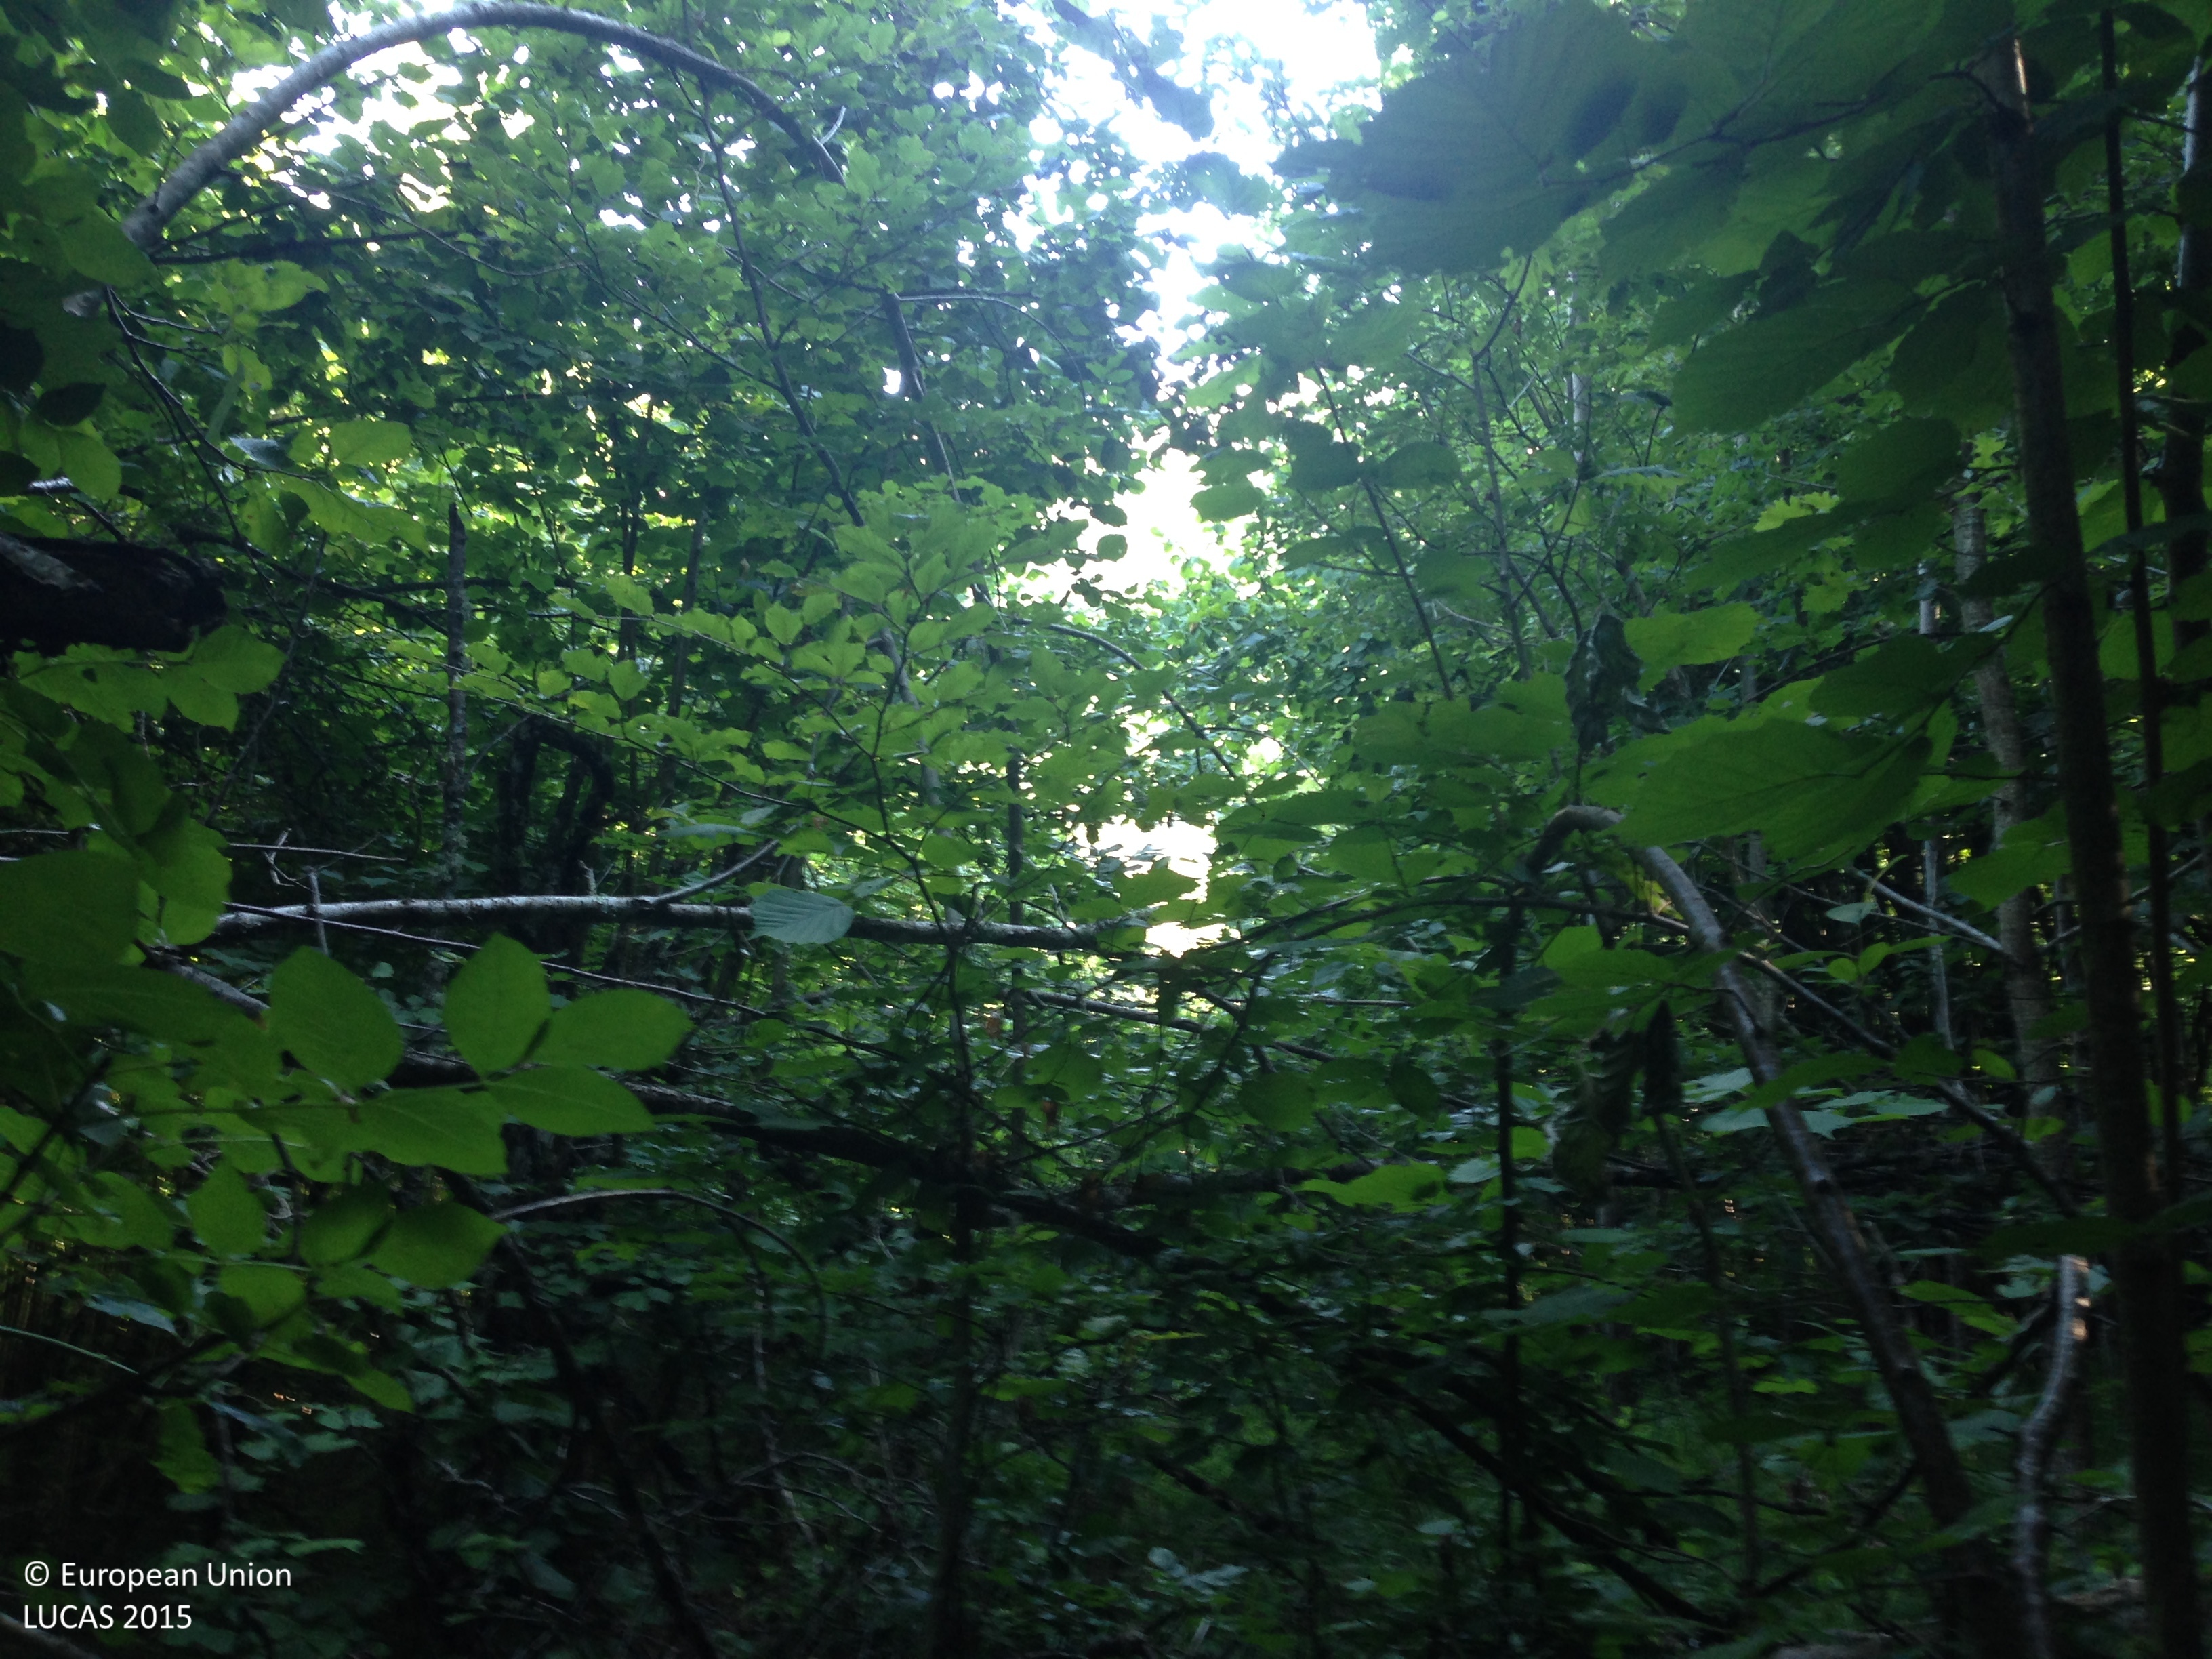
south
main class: Woodland
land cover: Broadleaved woodland
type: beech forest
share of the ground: 50 - 75 %
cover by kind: broadleaved forest trees 60 %, shrubs 30 %, lichens and mosses 5 %, consolidated bare surface 5 %
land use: Semi-natural and natural areas not in use
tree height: > 5 m
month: July
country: HR
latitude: 44.7102
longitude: 15.1562
